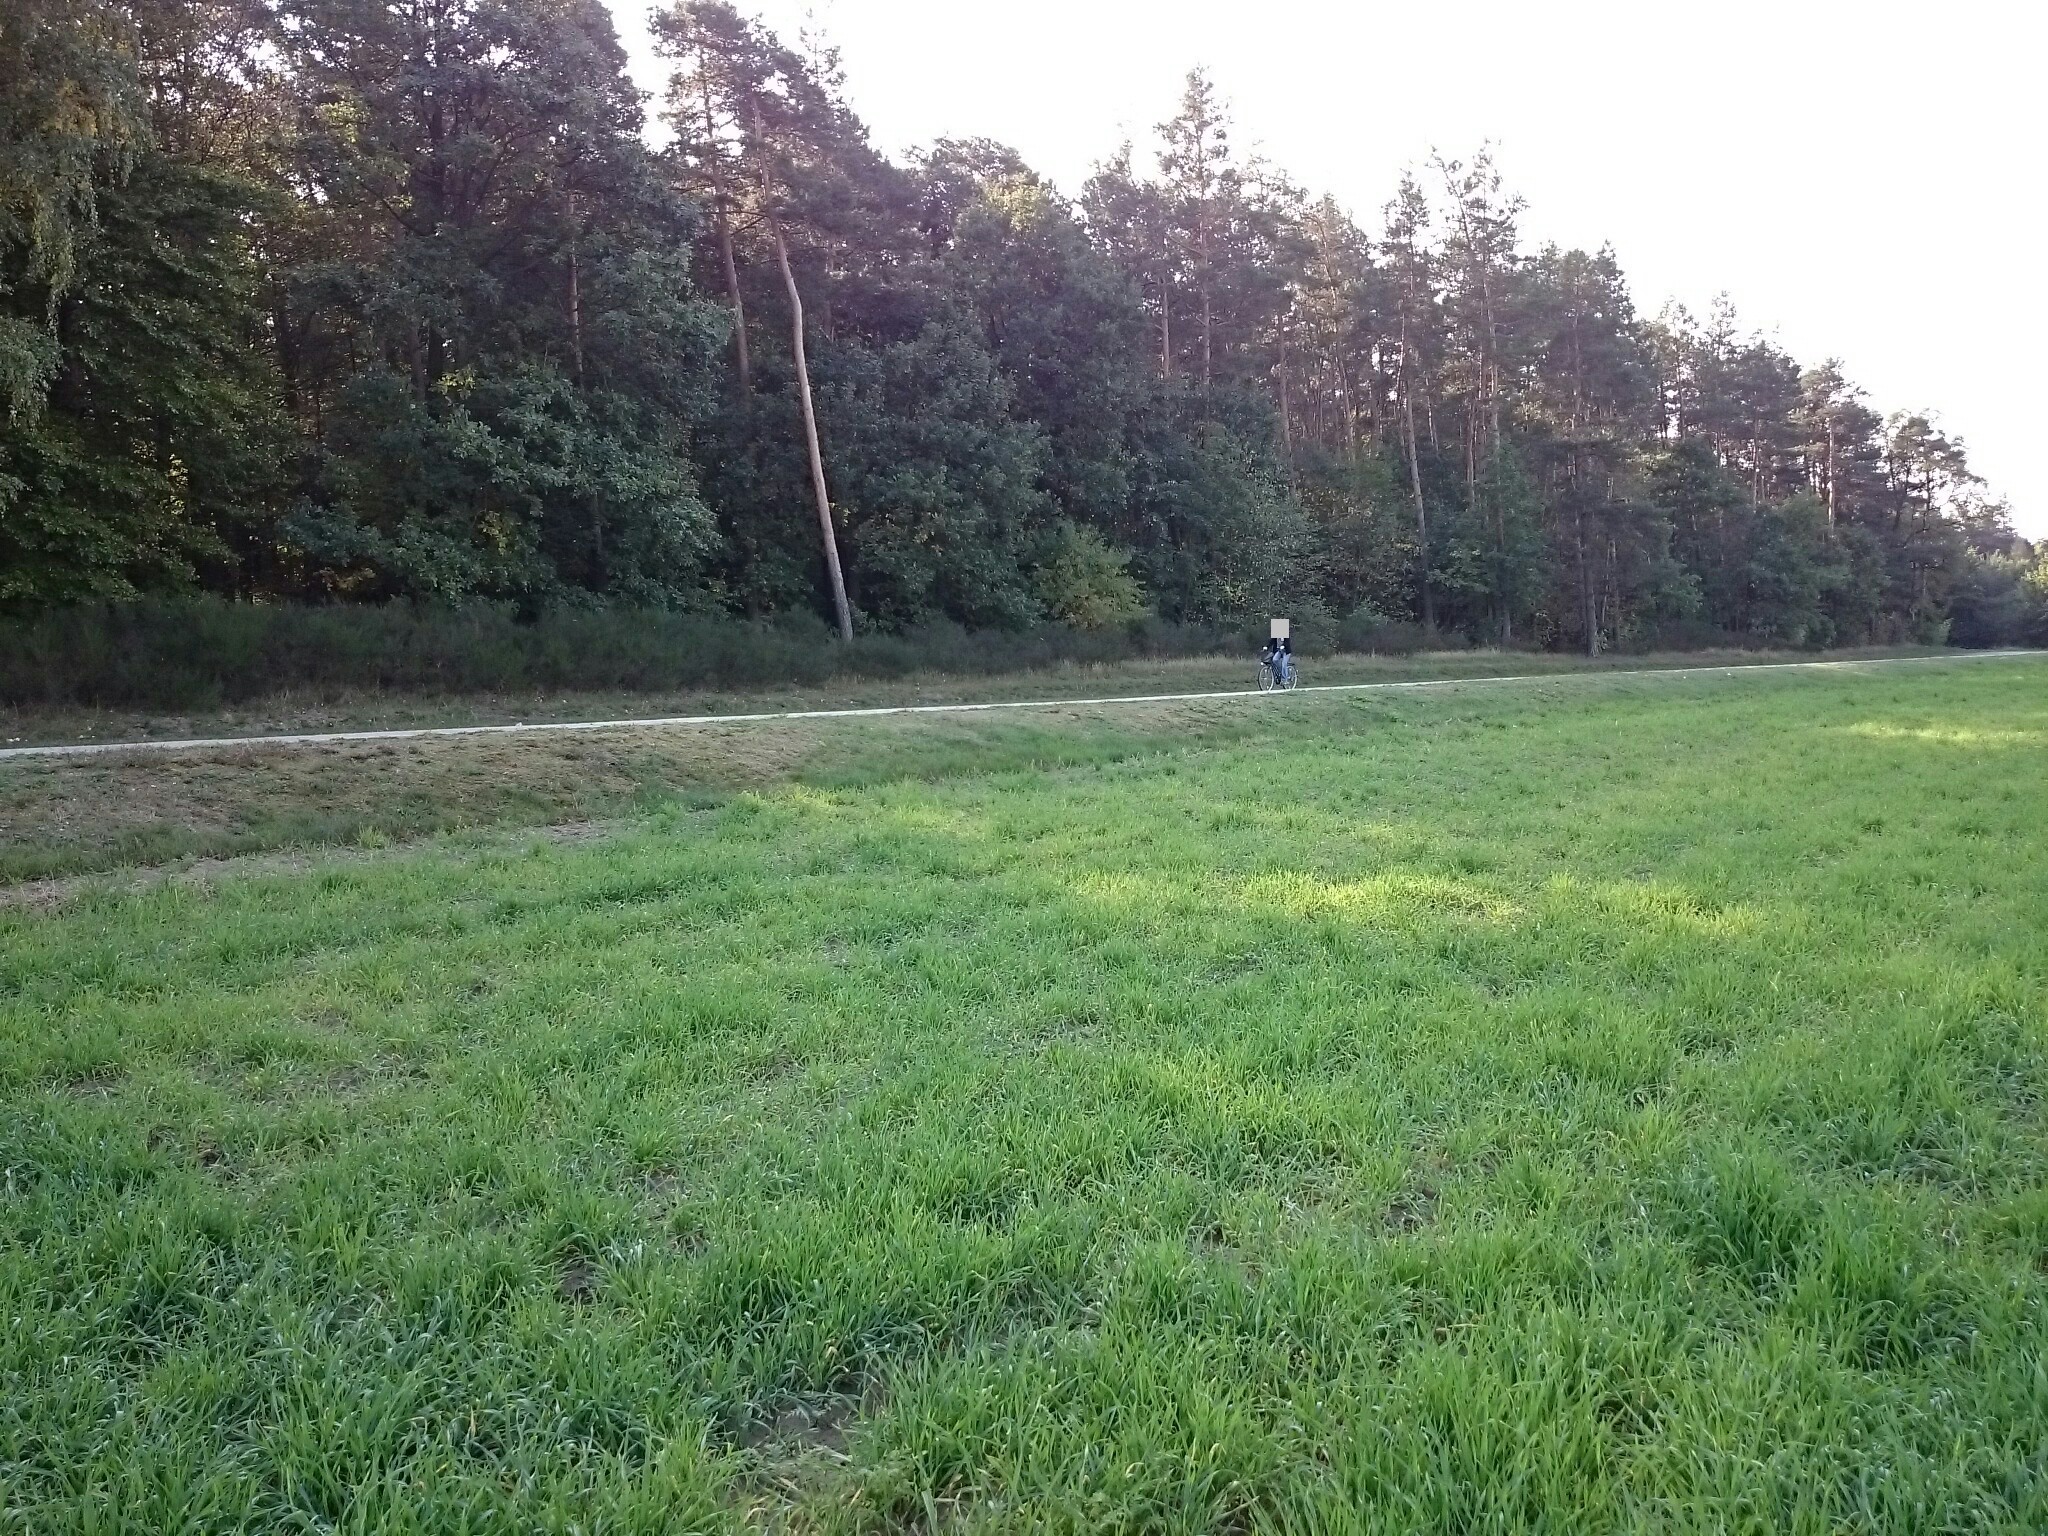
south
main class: Cropland
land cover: Temporary grasslands
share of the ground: > 75 %
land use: Agriculture (excluding fallow land and kitchen gardens)
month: September
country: PL
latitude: 51.6251
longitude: 17.3646
